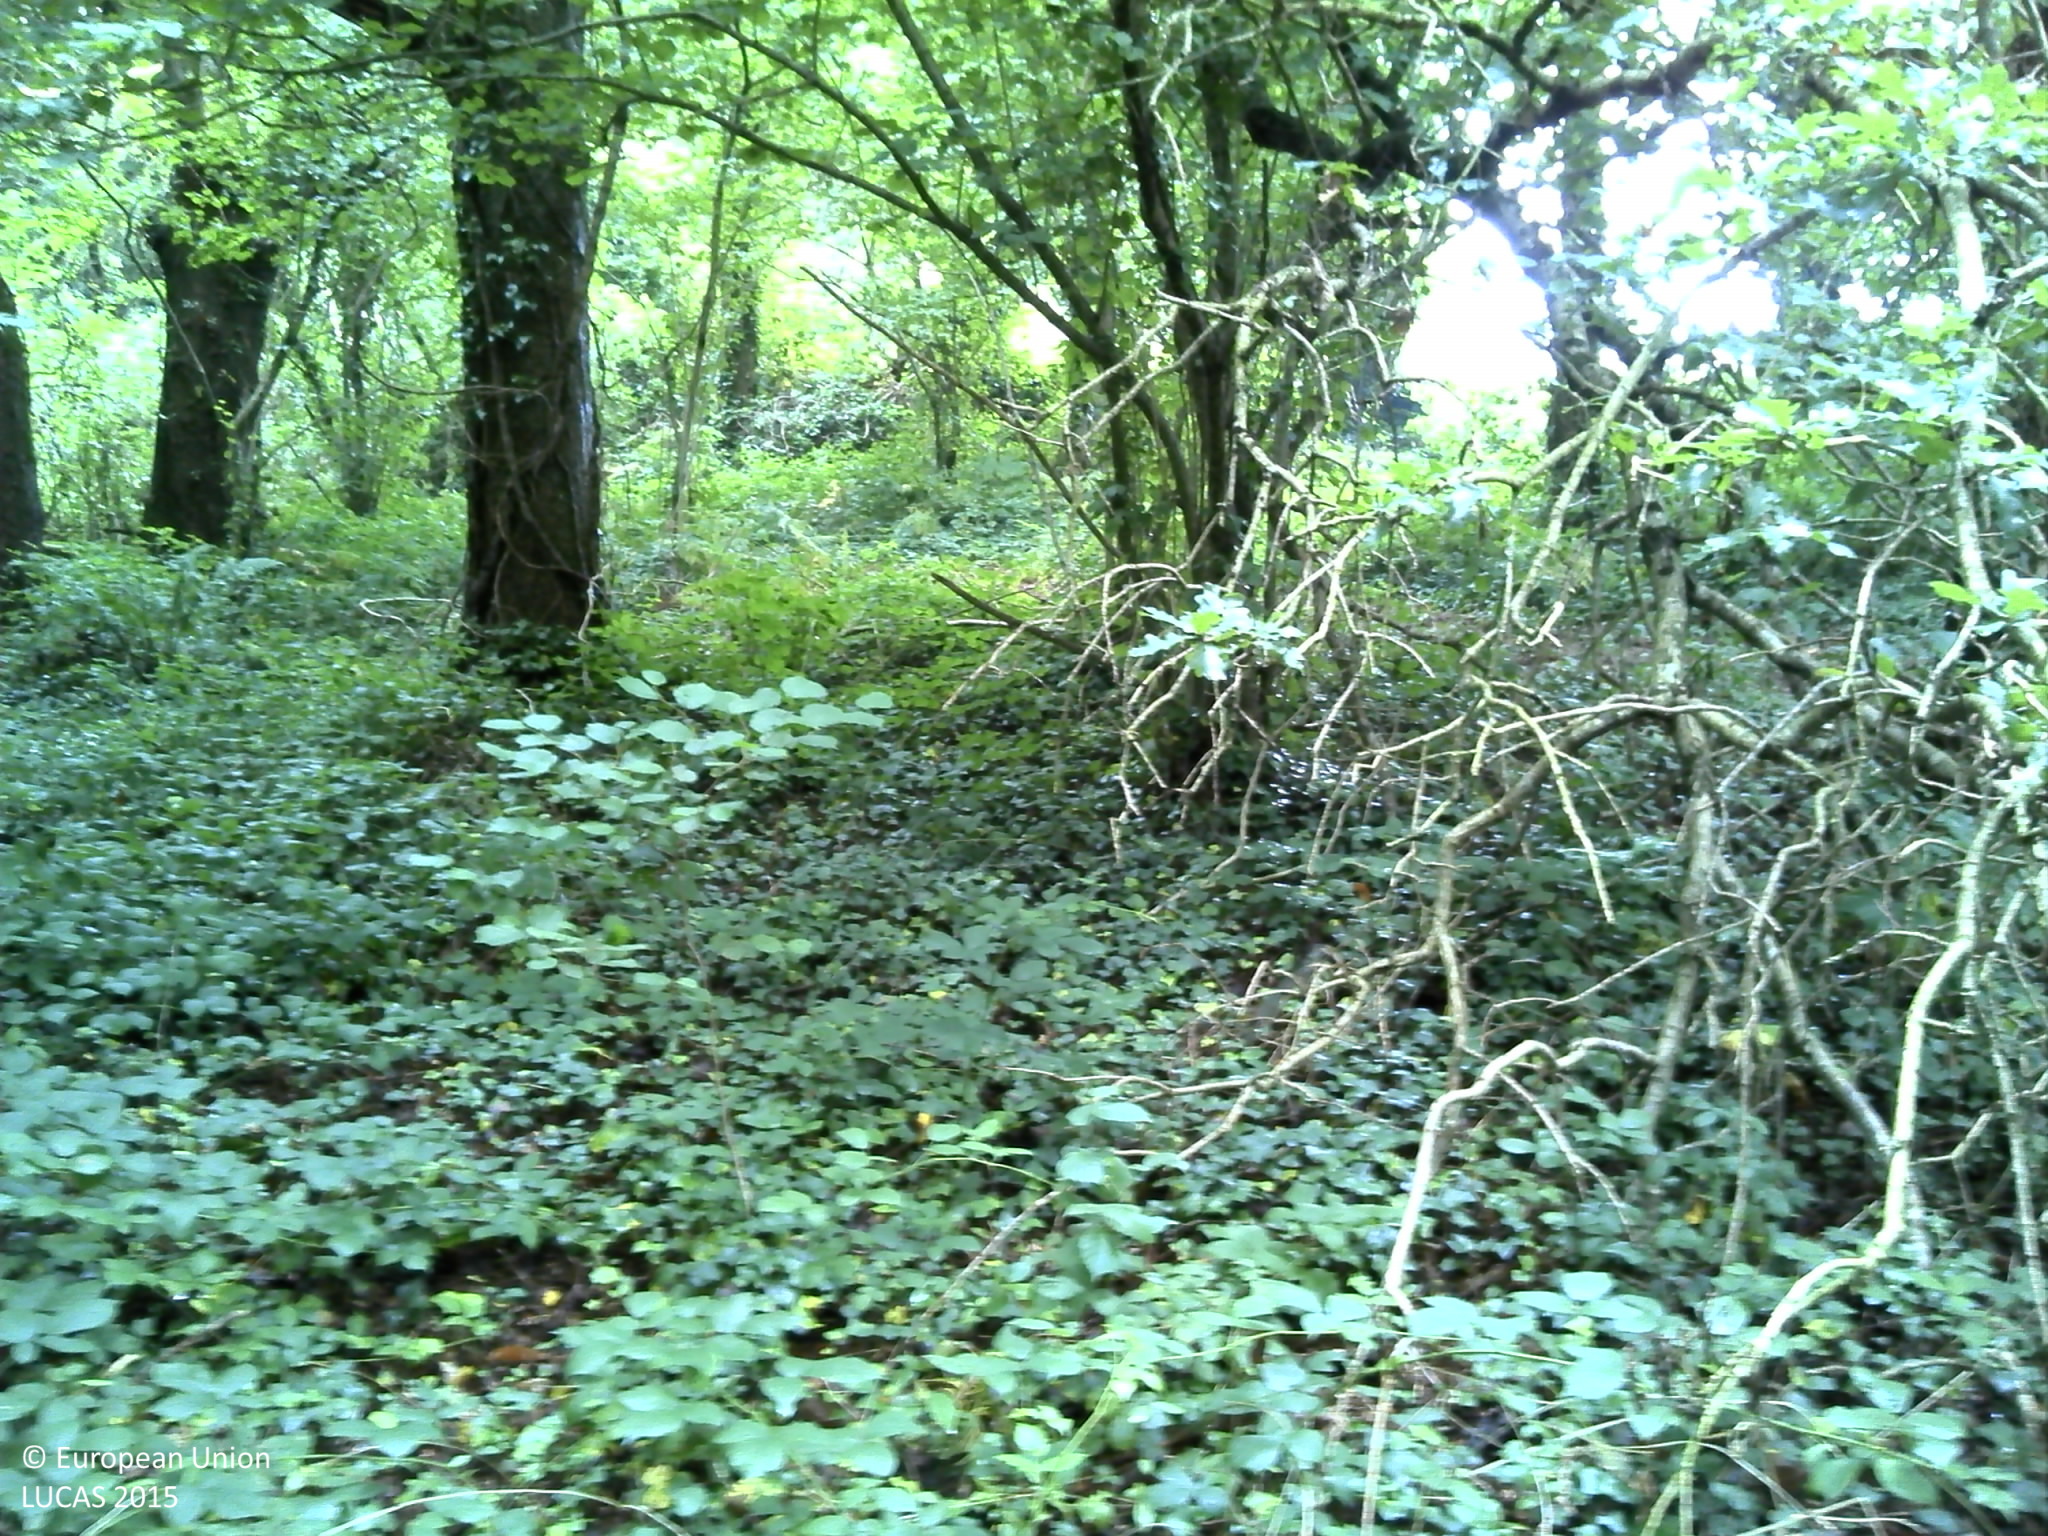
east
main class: Woodland
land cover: Broadleaved woodland
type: beech forest
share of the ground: > 75 %
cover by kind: broadleaved forest trees 100 %
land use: Forestry
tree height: > 5 m
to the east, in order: Broadleaved woodland; Fences; Grassland without tree/shrub cover; Fences; Broadleaved woodland; Other fresh vegetables
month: August
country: FR
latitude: 48.4821
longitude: -4.5075
